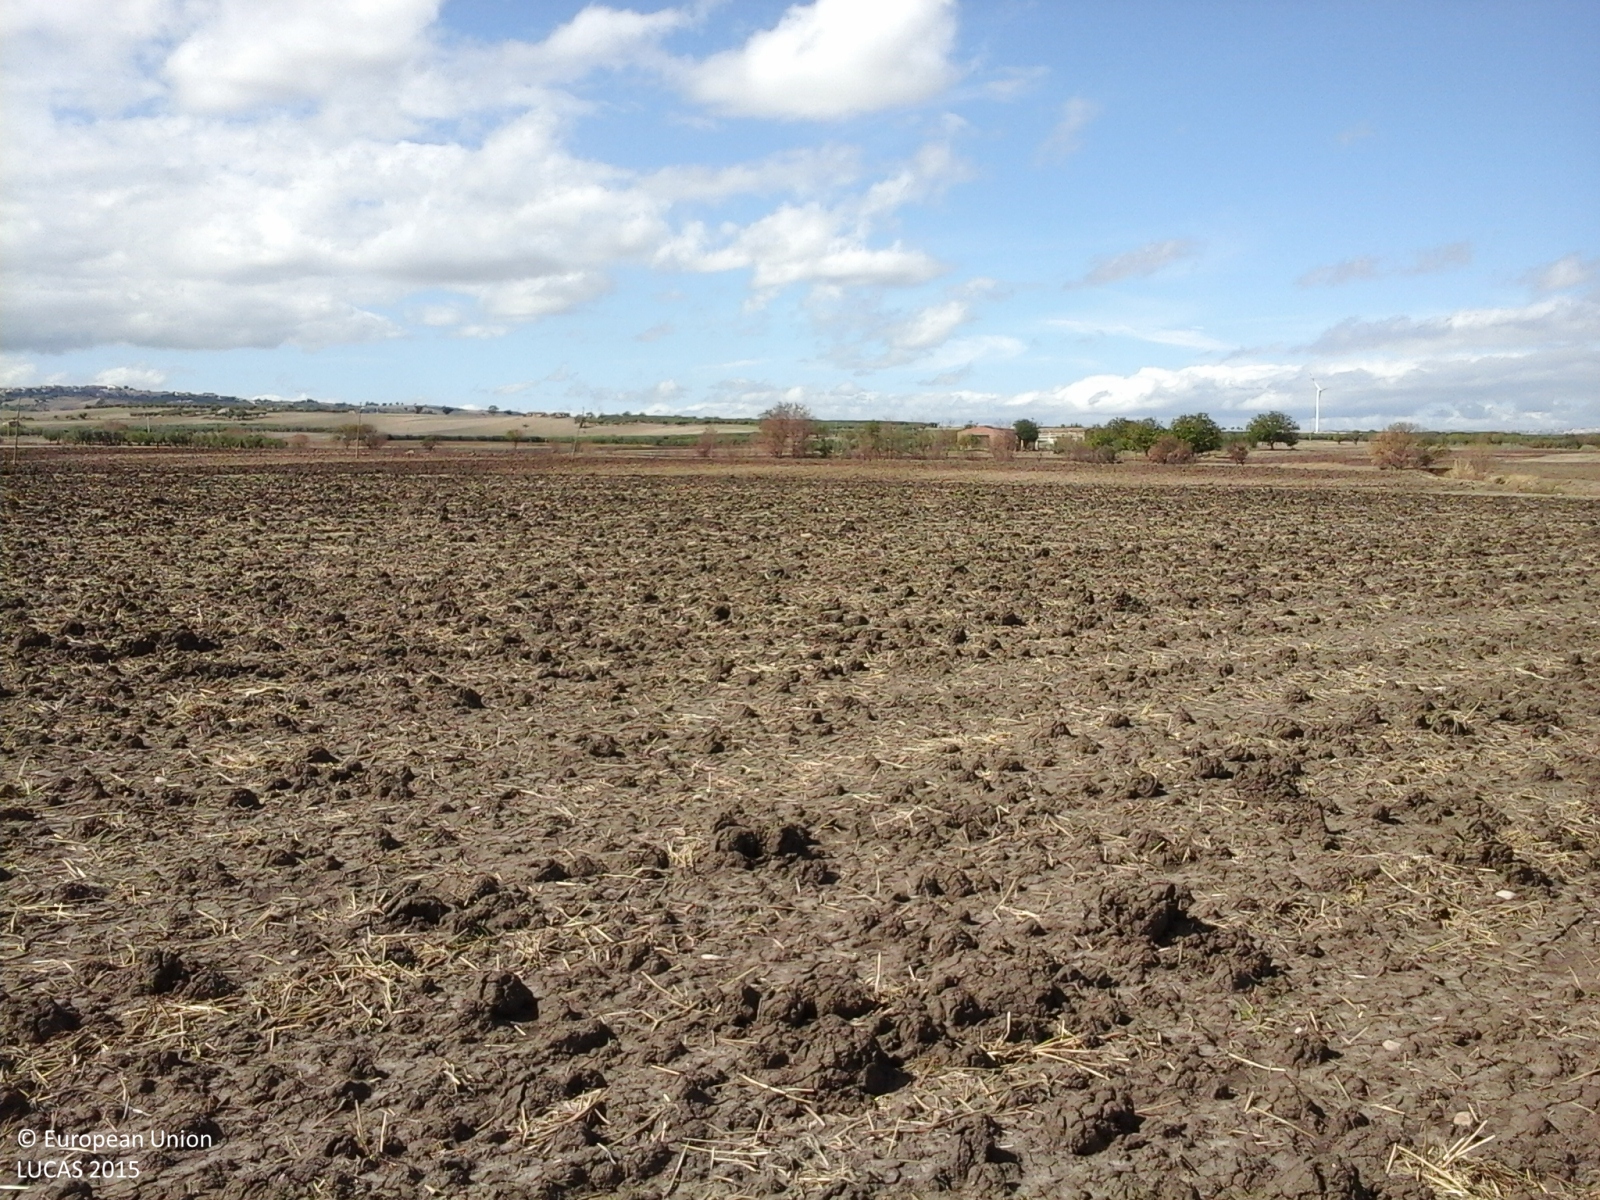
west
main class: Cropland
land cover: Durum wheat
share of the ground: > 75 %
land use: Agriculture (excluding fallow land and kitchen gardens)
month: September
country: IT
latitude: 41.6357
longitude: 15.1571
